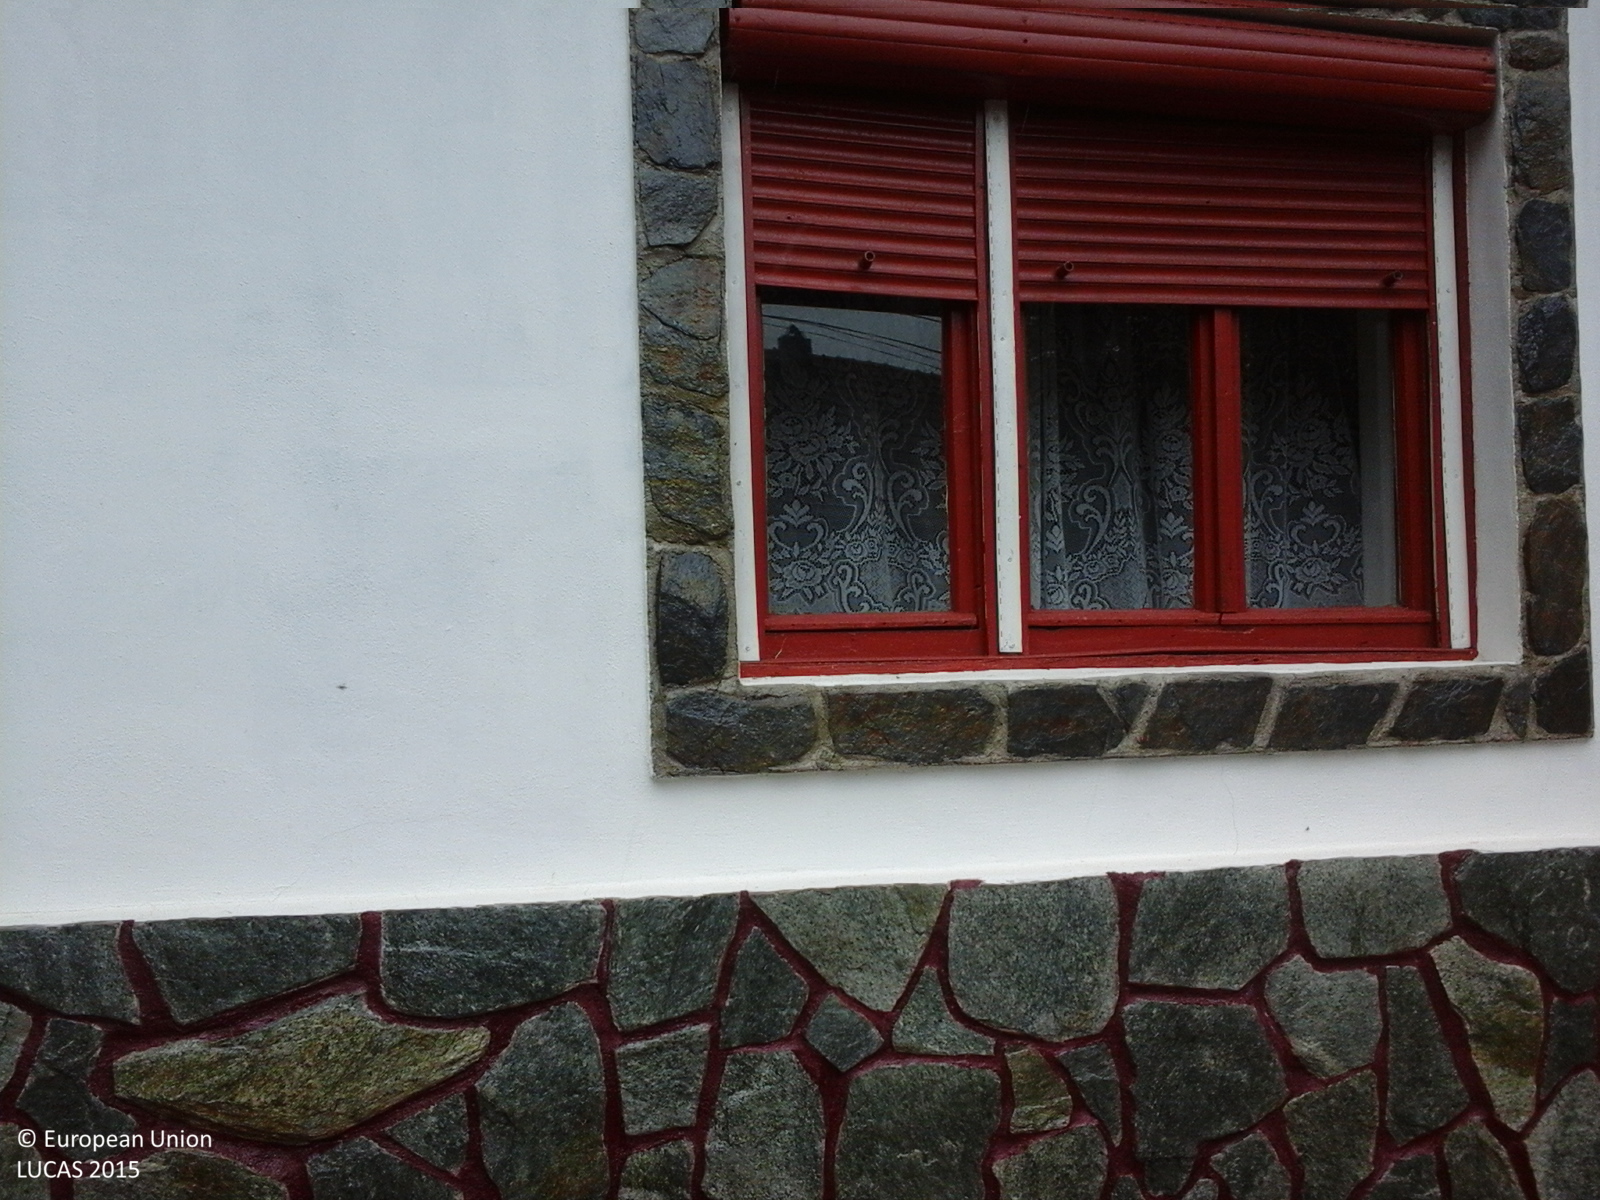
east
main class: Grassland
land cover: Grassland without tree/shrub cover
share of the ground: > 75 %
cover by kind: herbaceous plants 100 %
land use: Residential
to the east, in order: Grassland without tree/shrub cover; Artificial constructions in urban areas; Arable land (only in case pi); Fences; Abandoned hedges; Arable land (only in case pi); Abandoned hedges; Arable land (only in case pi); Abandoned hedges; Fences; Arable land (only in case pi); Abandoned hedges; Arable land (only in case pi); Abandoned hedges; Grassland with sparse tree/shrub cover; Maize; Single bushes/trees; Lucerne; Abandoned hedges; Grassland without tree/shrub cover; Single bushes/trees; Grassland without tree/shrub cover; Other fruit trees and berries; Shrubland with sparse tree cover; Grass margins; Paved roads, cycling and walking lanes
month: August
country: RO
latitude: 45.0414
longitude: 22.2643
